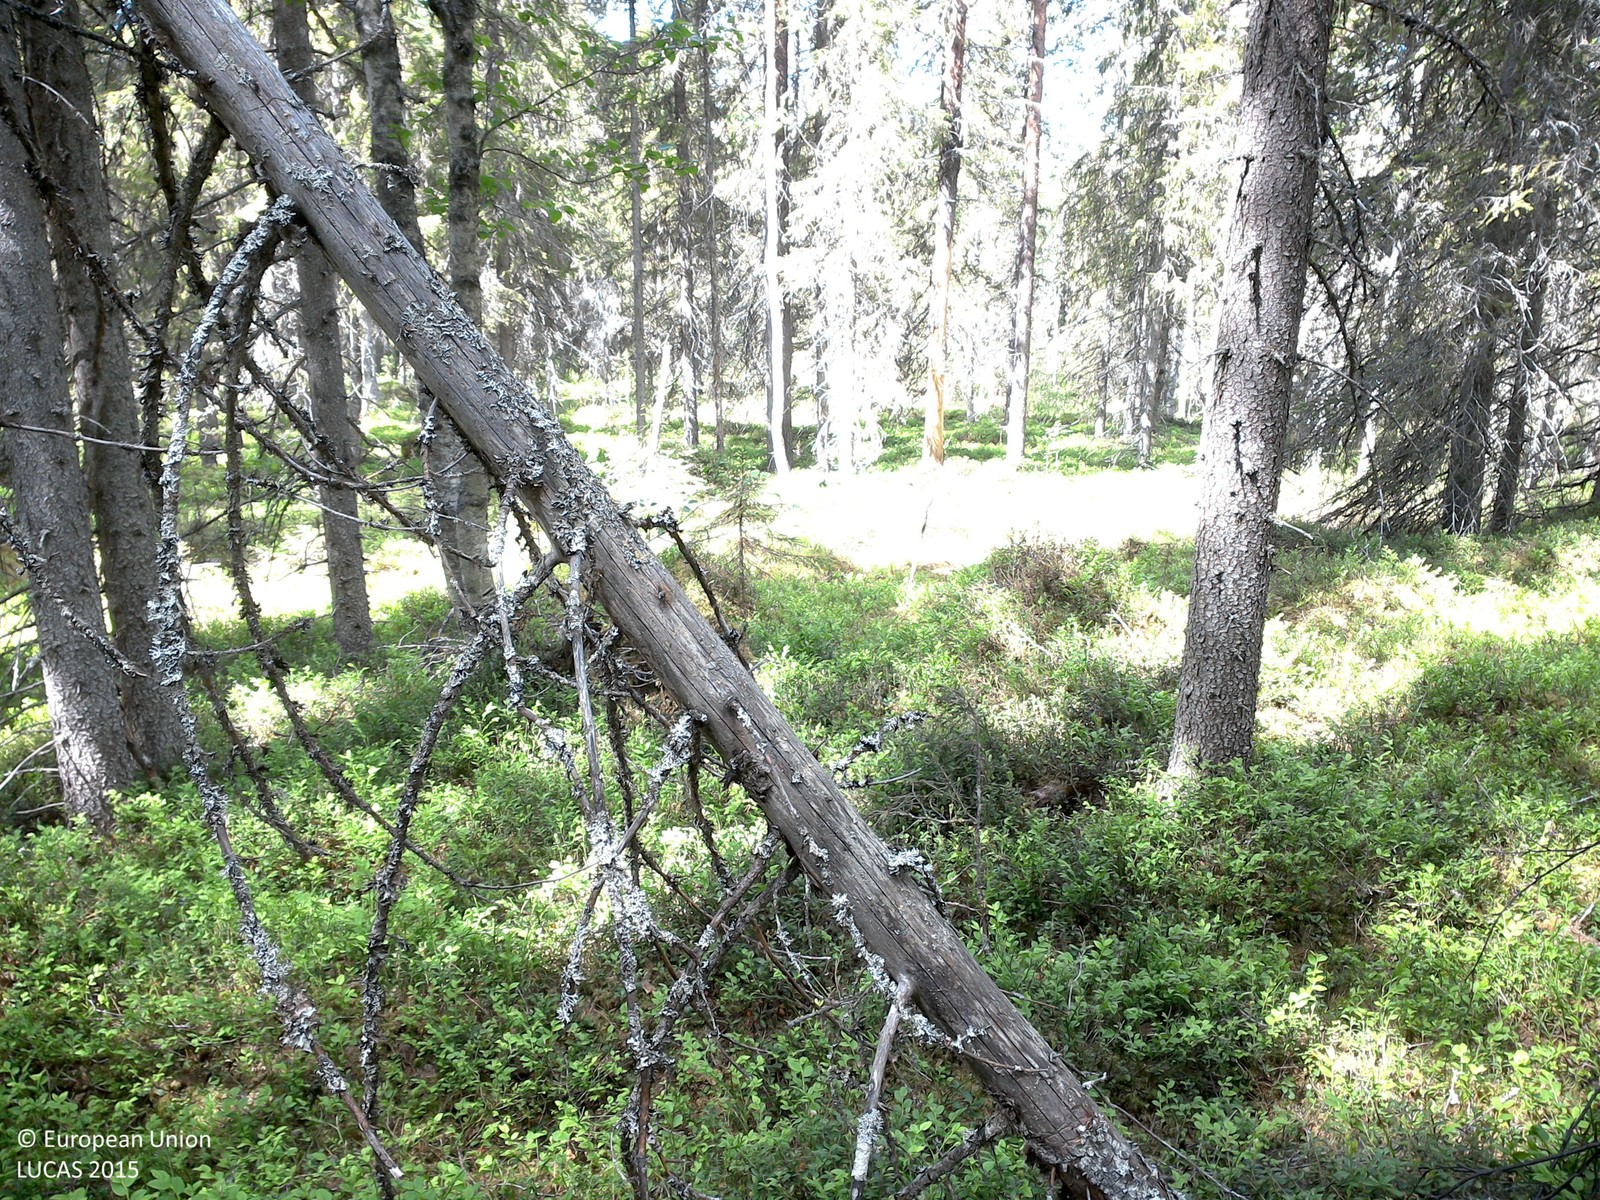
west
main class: Woodland
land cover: Spruce dominated mixed woodland
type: boreal forest
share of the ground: 25 - 50 %
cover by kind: shrubs 50 %, coniferous forest trees 30 %, broadleaved forest trees 10 %, lichens and mosses 10 %
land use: Forestry
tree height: > 5 m
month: June
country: SE
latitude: 66.6562
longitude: 22.9790
